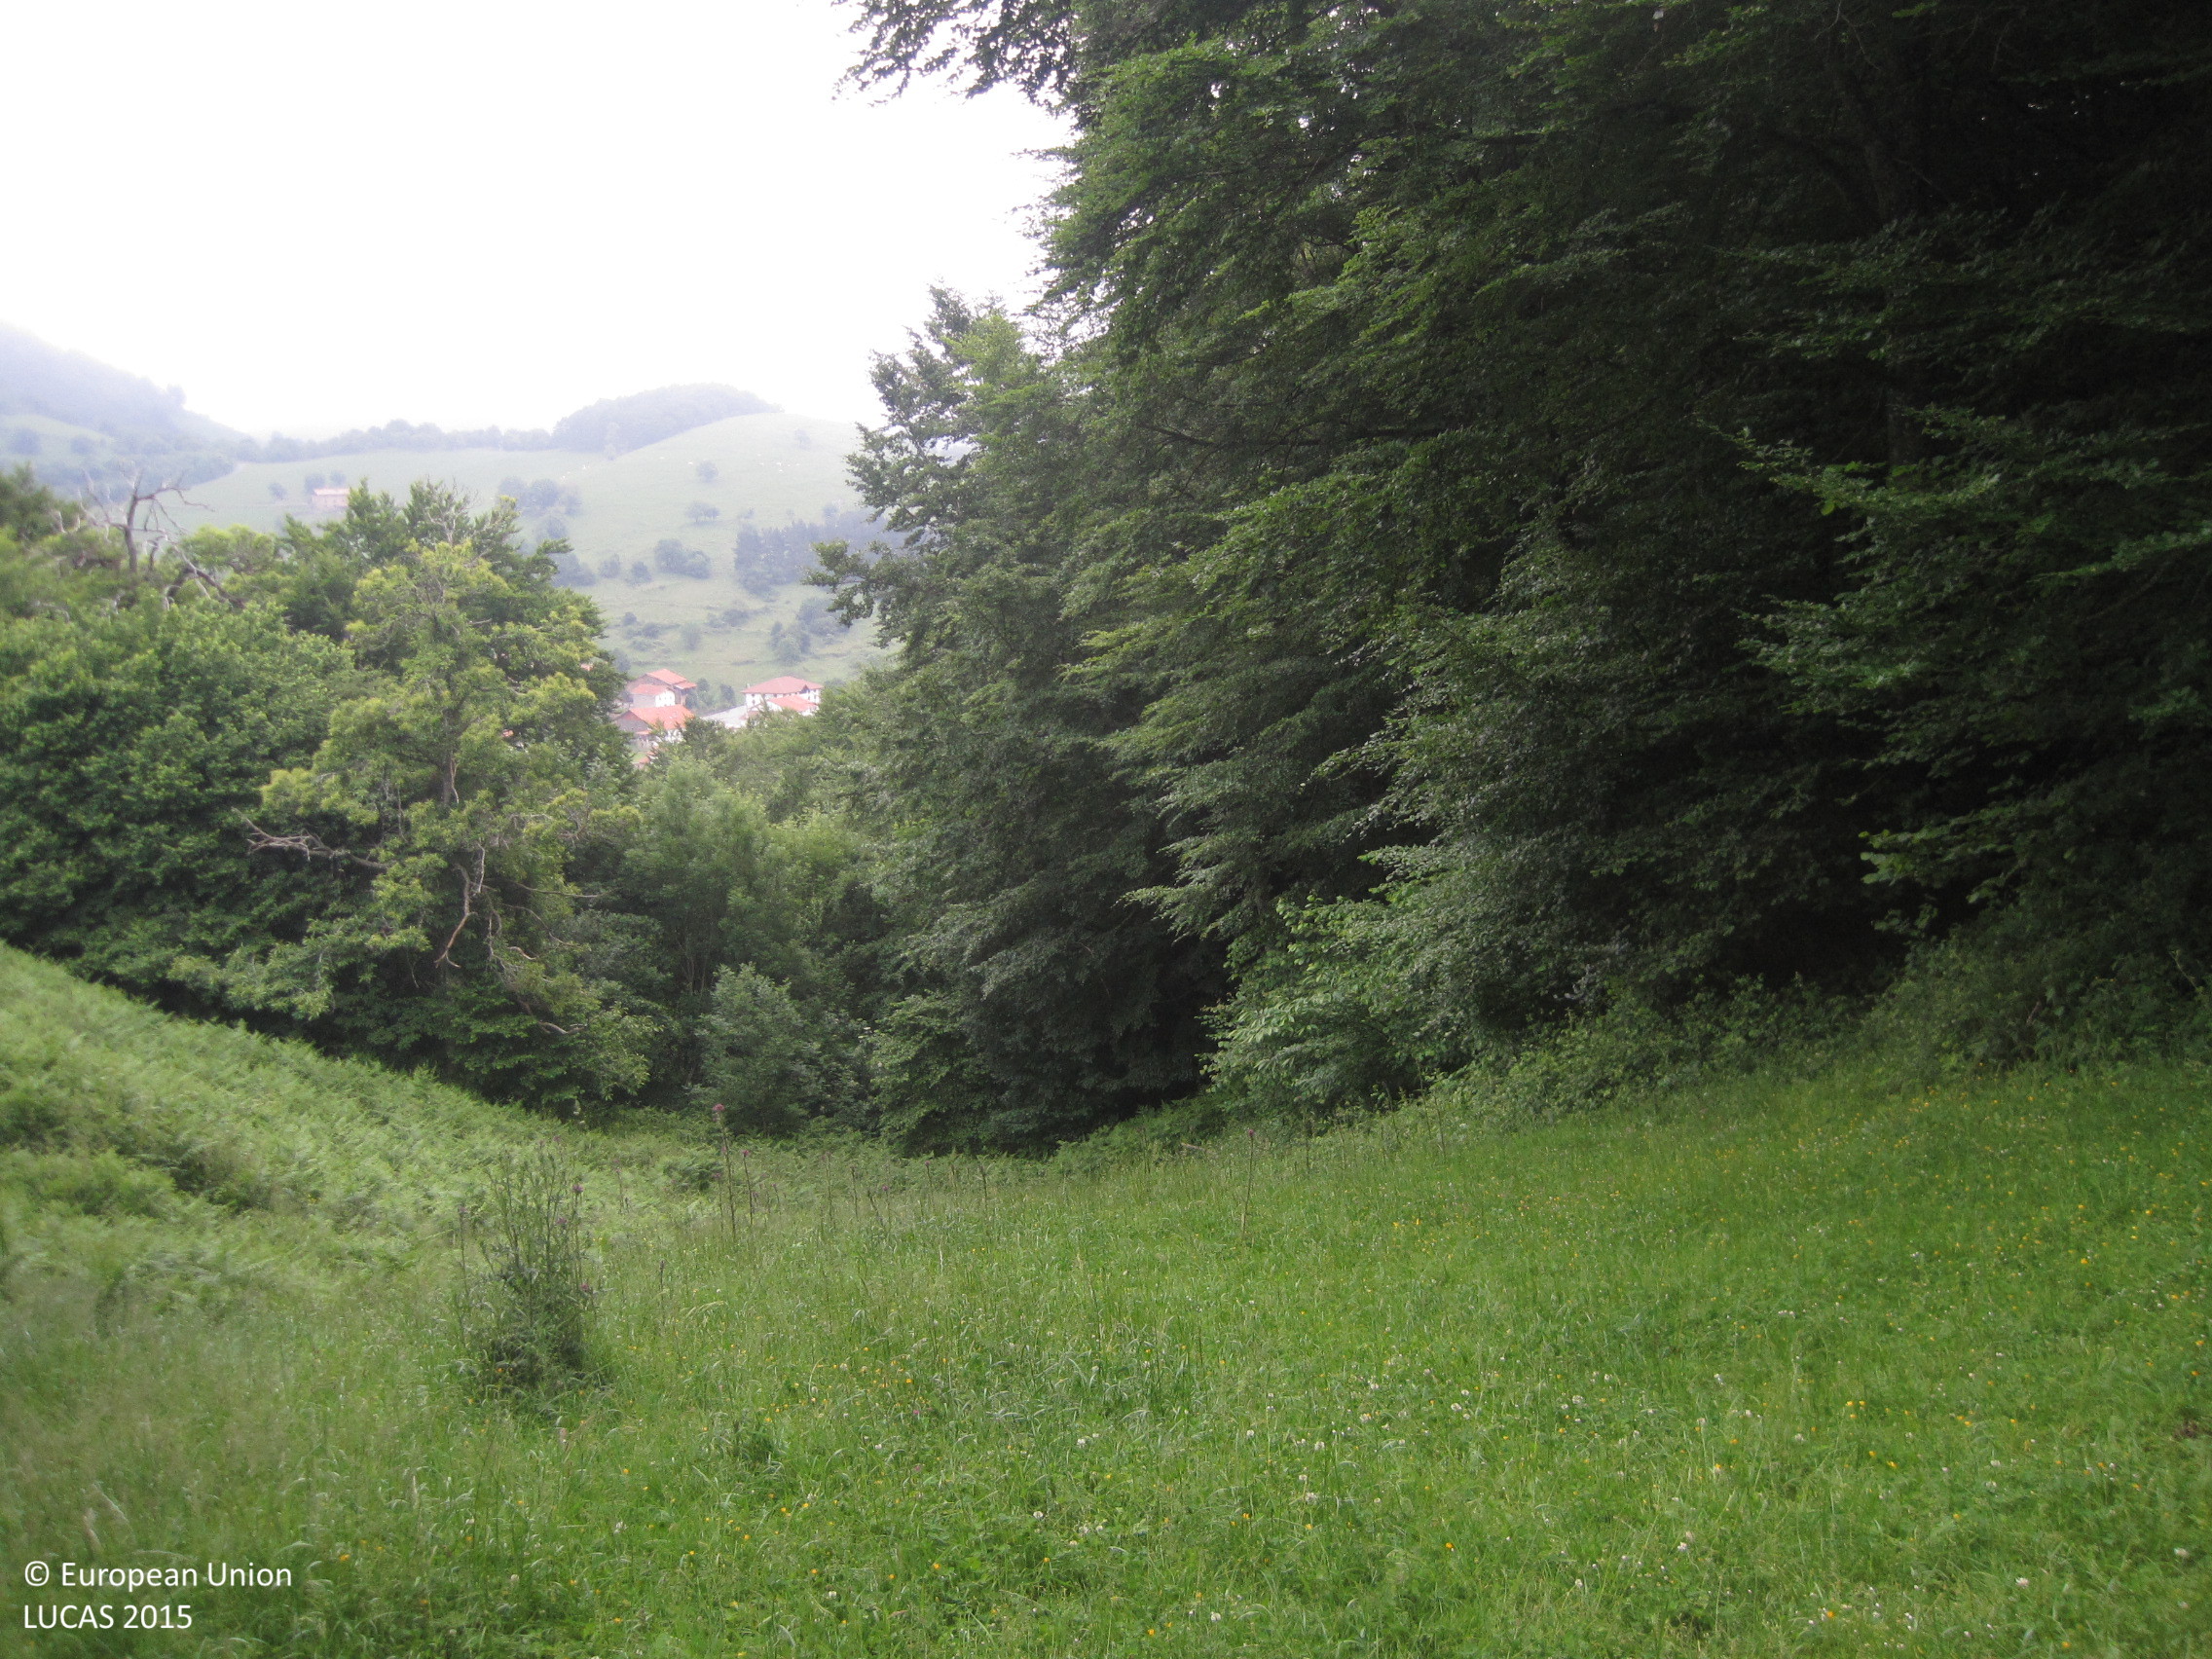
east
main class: Woodland
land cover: Broadleaved woodland
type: beech forest
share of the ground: 50 - 75 %
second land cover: Grassland without tree/shrub cover
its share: > 75 %
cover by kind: herbaceous plants 60 %, broadleaved forest trees 40 %
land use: Forestry
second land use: Agriculture (excluding fallow land and kitchen gardens)
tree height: > 5 m
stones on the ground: < 10 %
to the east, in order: Broadleaved woodland; Grassland without tree/shrub cover; Broadleaved woodland; Fences; Broadleaved woodland
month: June
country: ES
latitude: 43.0356
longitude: -1.8134
